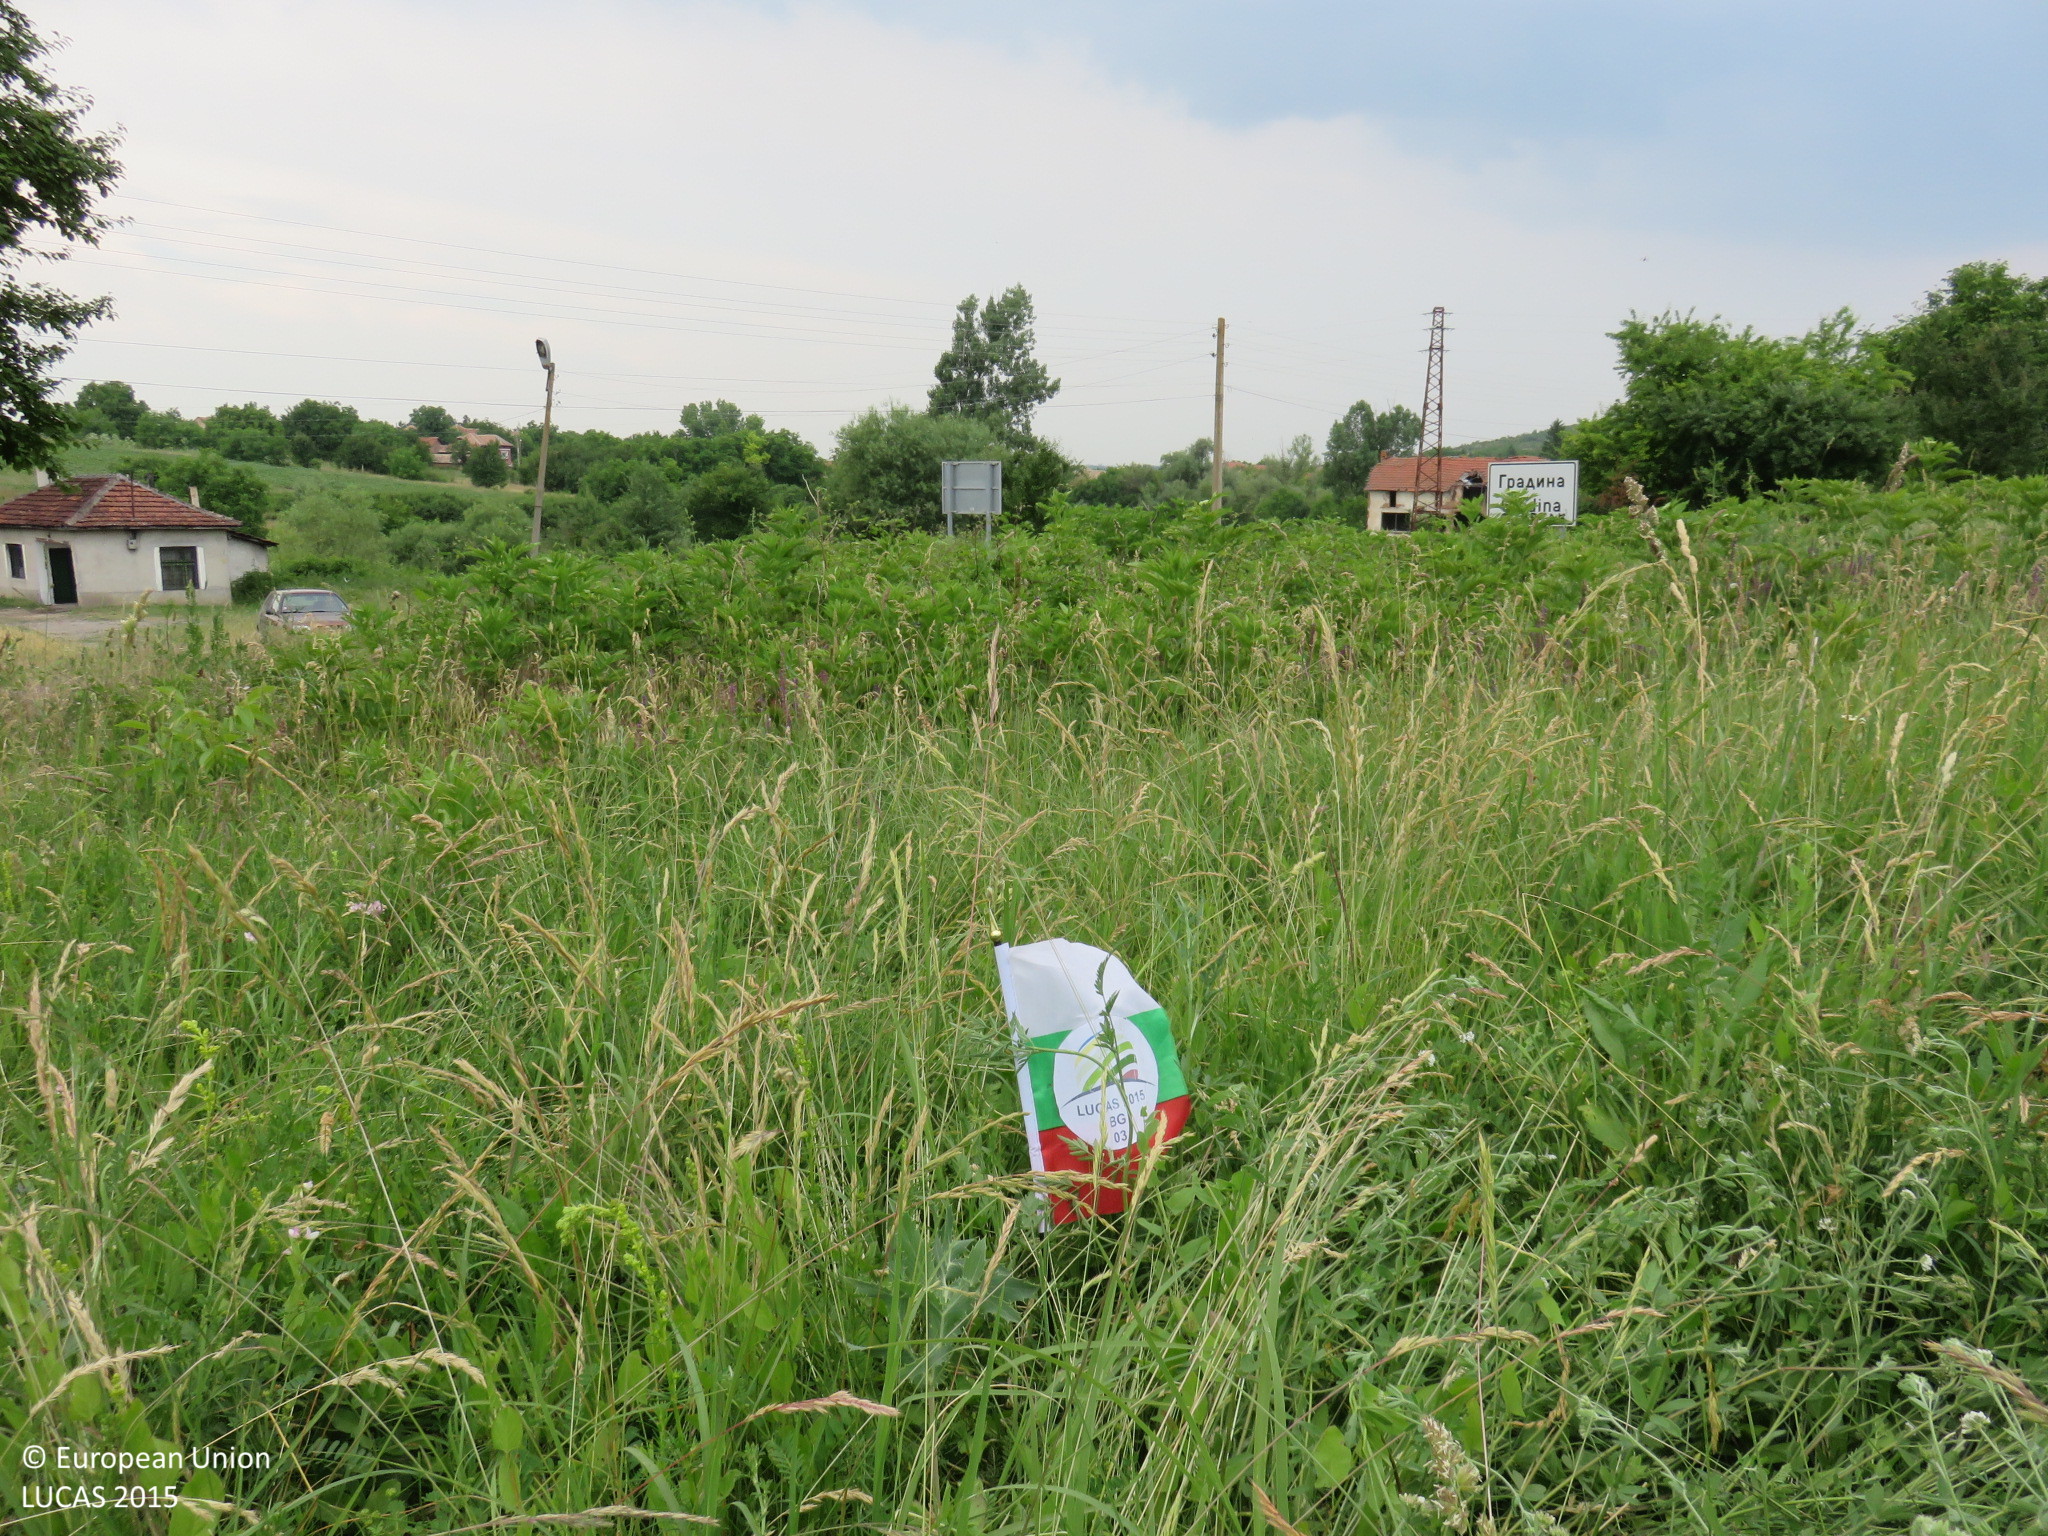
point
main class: Grassland
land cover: Grassland without tree/shrub cover
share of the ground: > 75 %
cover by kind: herbaceous plants 100 %
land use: Semi-natural and natural areas not in use
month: June
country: BG
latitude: 43.3468
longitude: 24.4809
